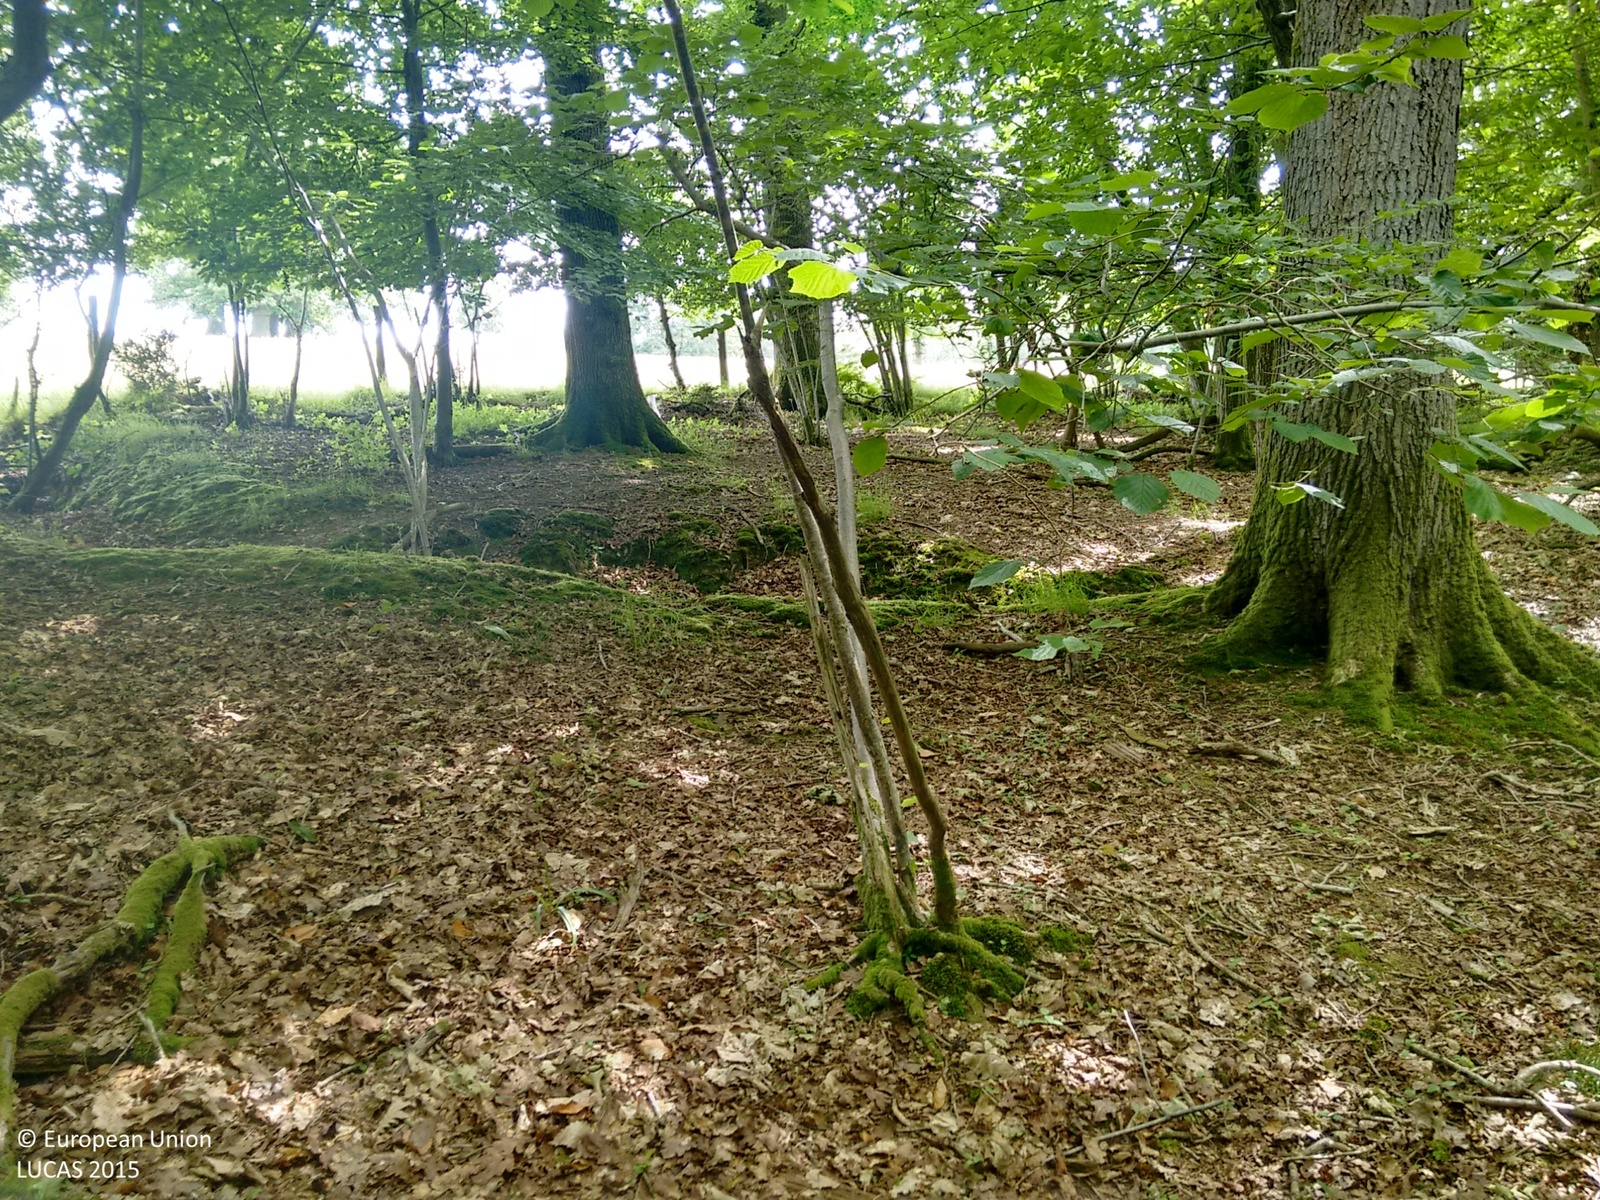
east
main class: Woodland
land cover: Broadleaved woodland
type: mesophytic deciduous forest
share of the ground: > 75 %
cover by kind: broadleaved forest trees 90 %, shrubs 10 %
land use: Forestry
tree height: > 5 m
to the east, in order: Broadleaved woodland; Fences; Grassland with sparse tree/shrub cover; Tracks; Grassland with sparse tree/shrub cover; Fences; Pine dominated coniferous woodland; Broadleaved woodland
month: June
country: GB
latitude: 51.0939
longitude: -0.1003
